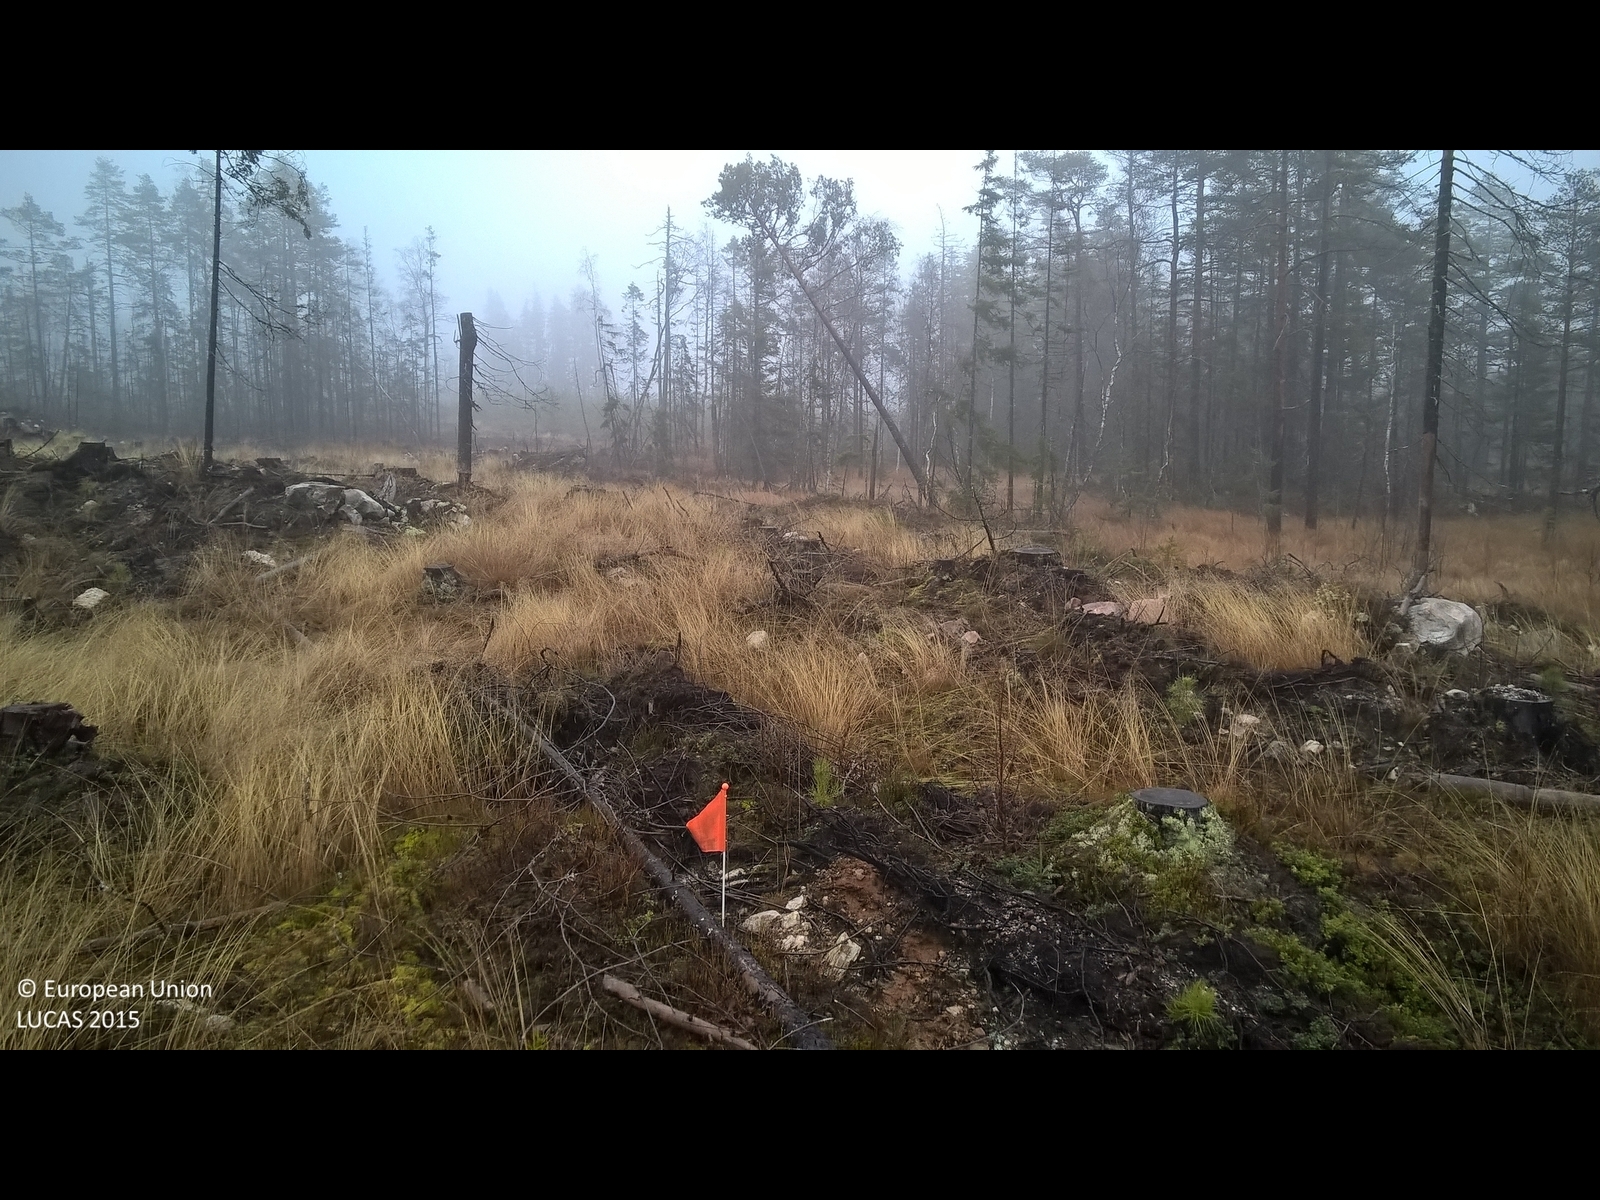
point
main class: Grassland
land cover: Grassland with sparse tree/shrub cover
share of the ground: > 75 %
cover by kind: herbaceous plants 75 %, shrubs 10 %, lichens and mosses 10 %, coniferous forest trees 5 %
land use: Forestry
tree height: > 5 m
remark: Clear cut
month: November
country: SE
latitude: 60.0634
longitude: 14.7858
